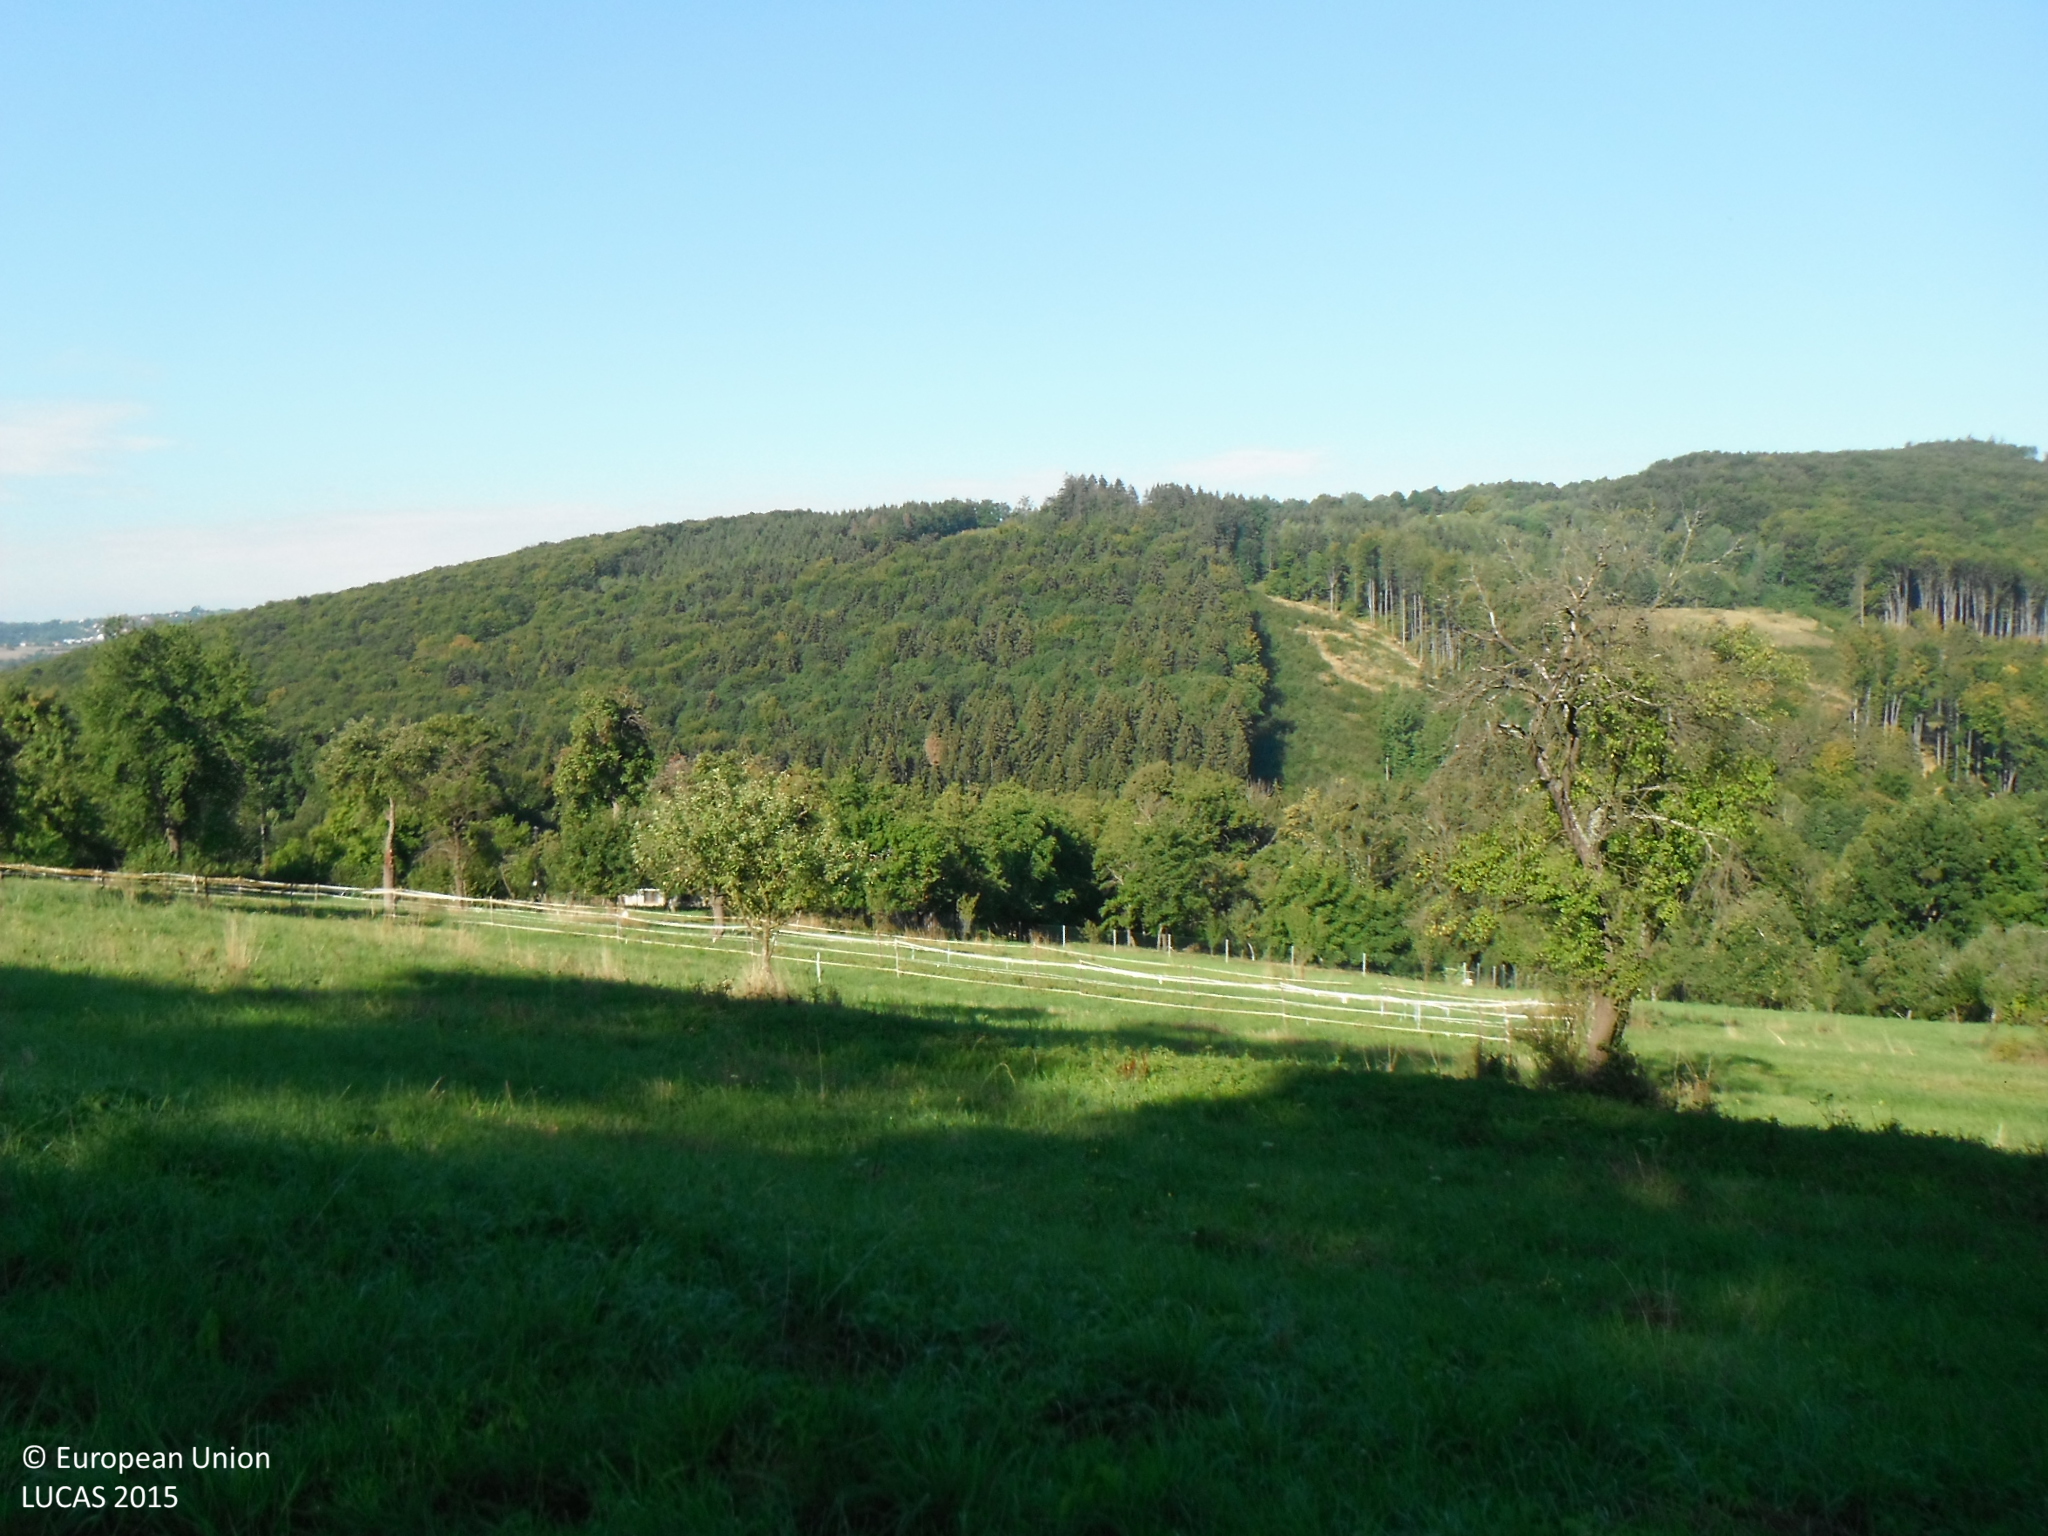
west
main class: Grassland
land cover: Grassland without tree/shrub cover
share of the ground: > 75 %
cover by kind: herbaceous plants 100 %
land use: Agriculture (excluding fallow land and kitchen gardens)
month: September
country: SK
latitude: 49.0004
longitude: 17.9833
